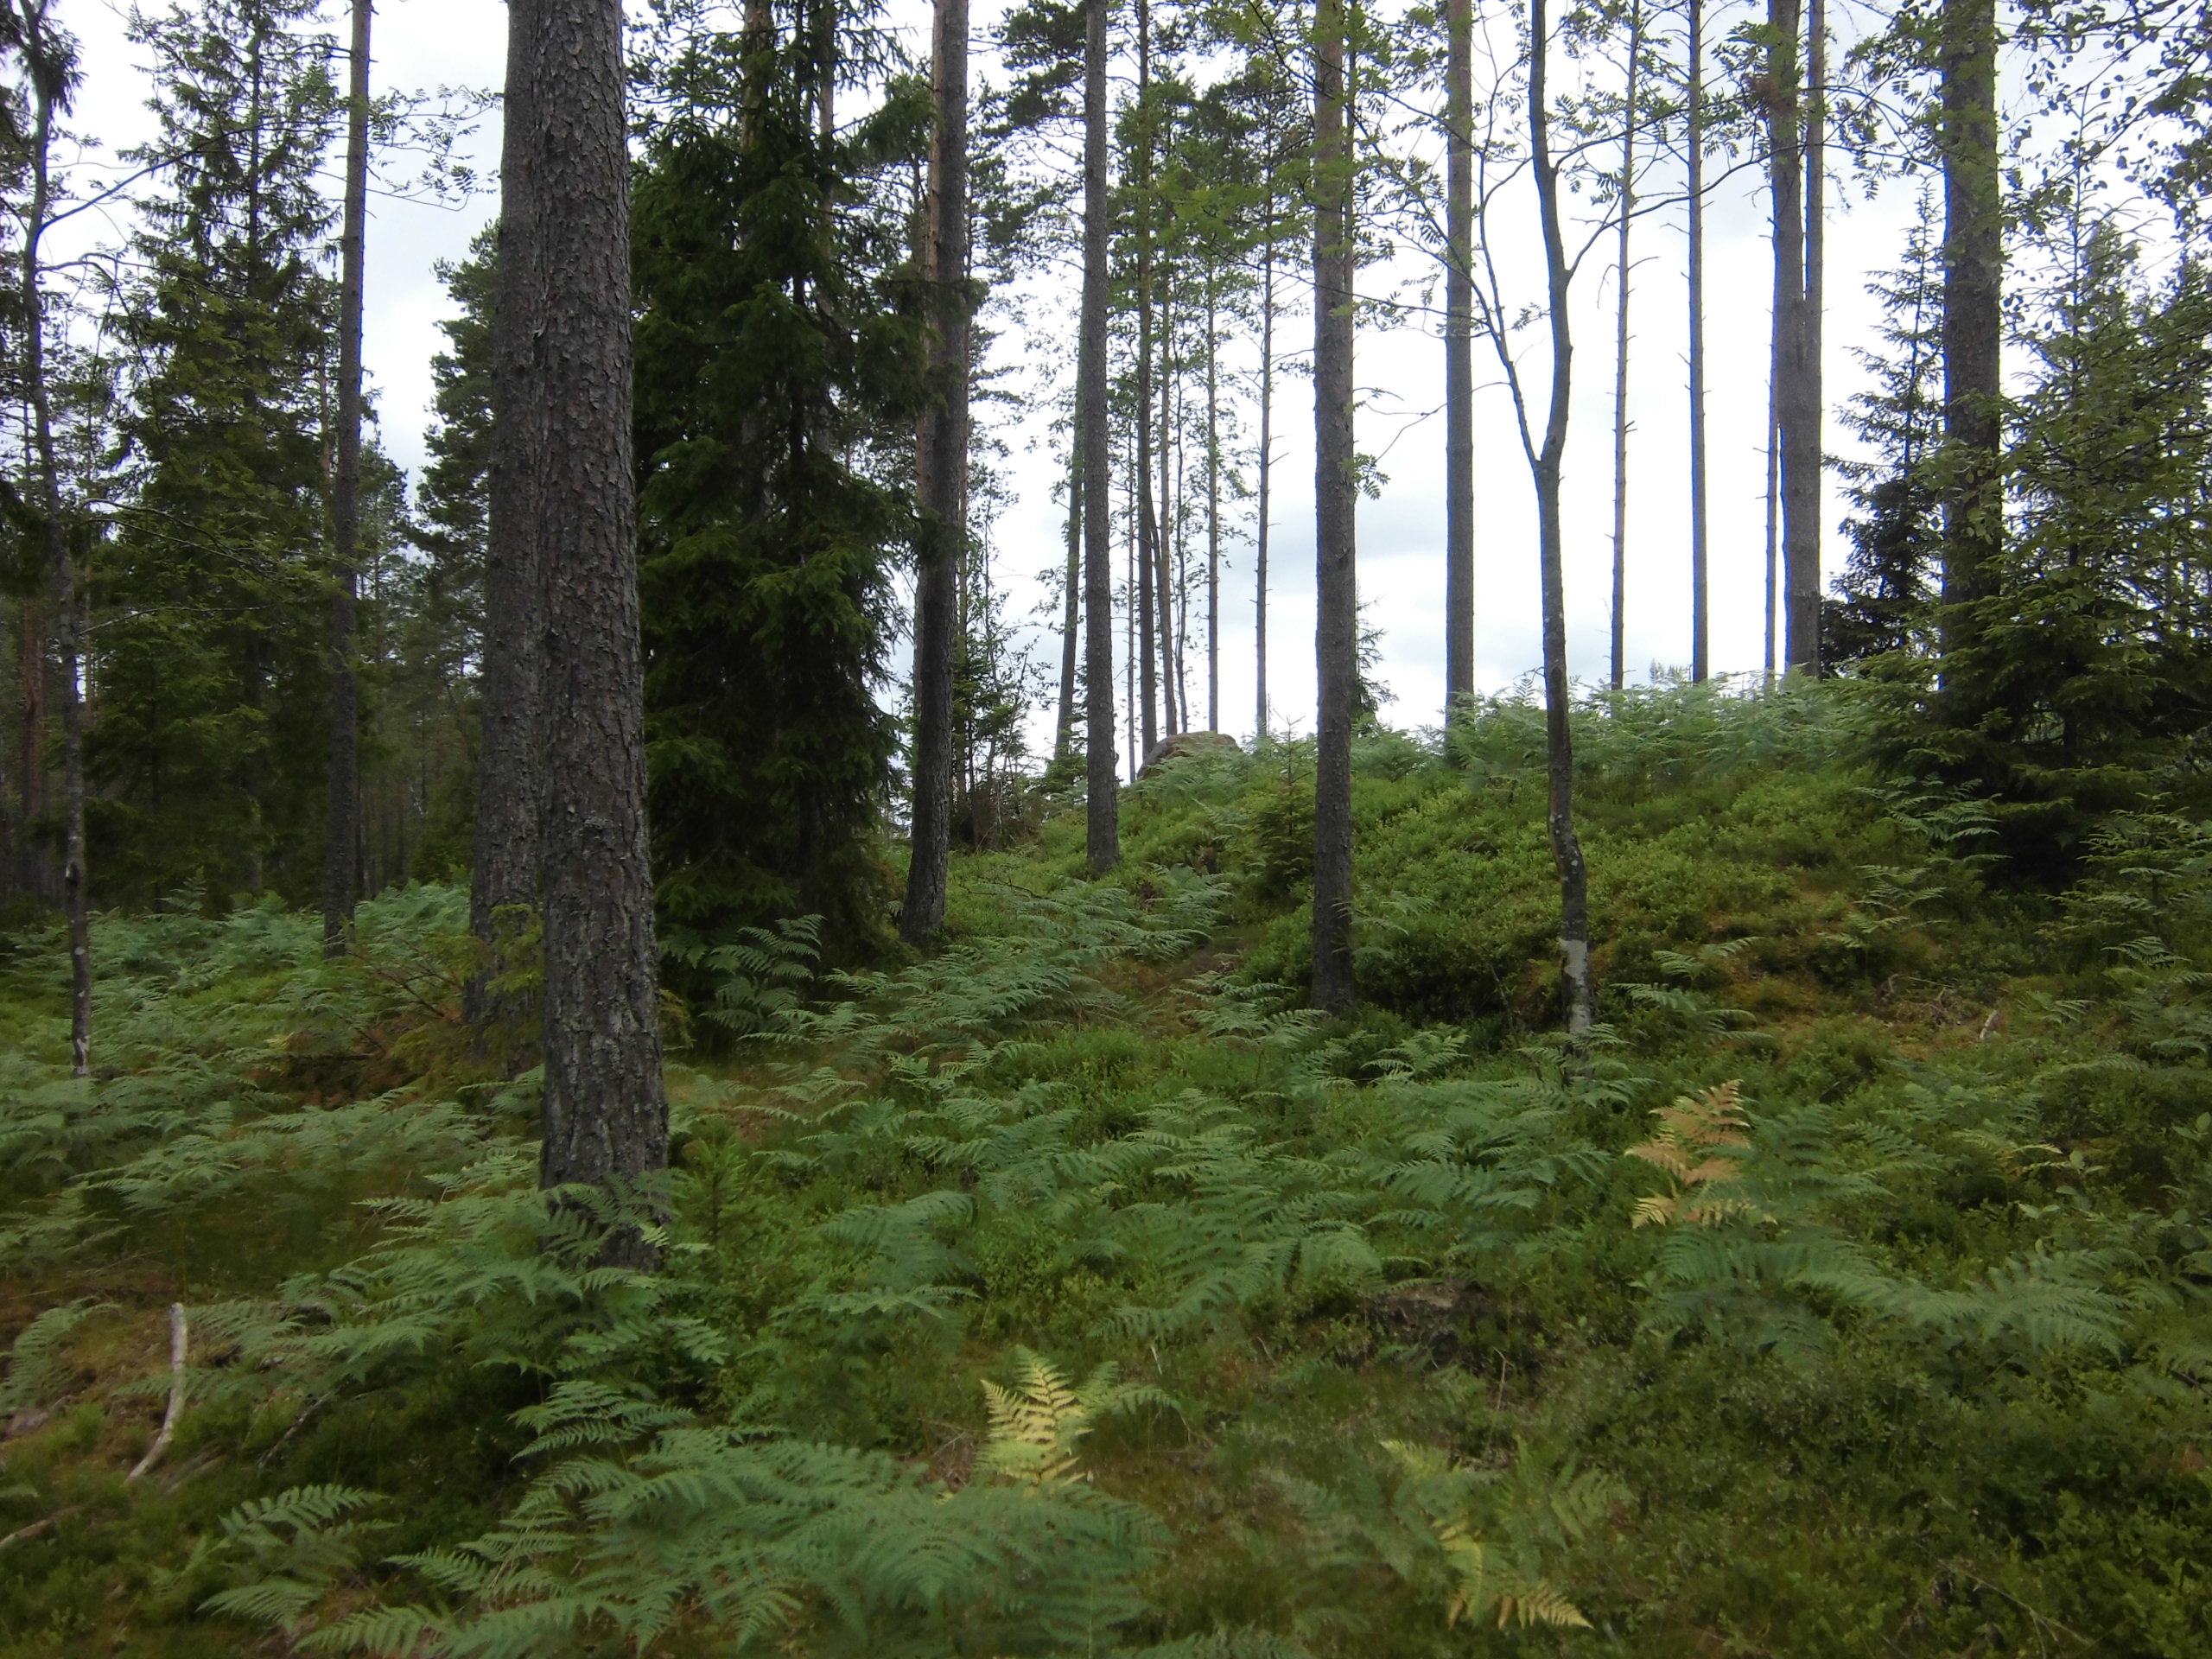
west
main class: Woodland
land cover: Pine dominated coniferous woodland
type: boreal forest
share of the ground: 25 - 50 %
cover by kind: coniferous forest trees 40 %, shrubs 40 %, herbaceous plants 10 %, broadleaved forest trees 5 %, lichens and mosses 5 %
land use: Forestry
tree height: > 5 m
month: July
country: SE
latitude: 57.2749
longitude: 15.1215
